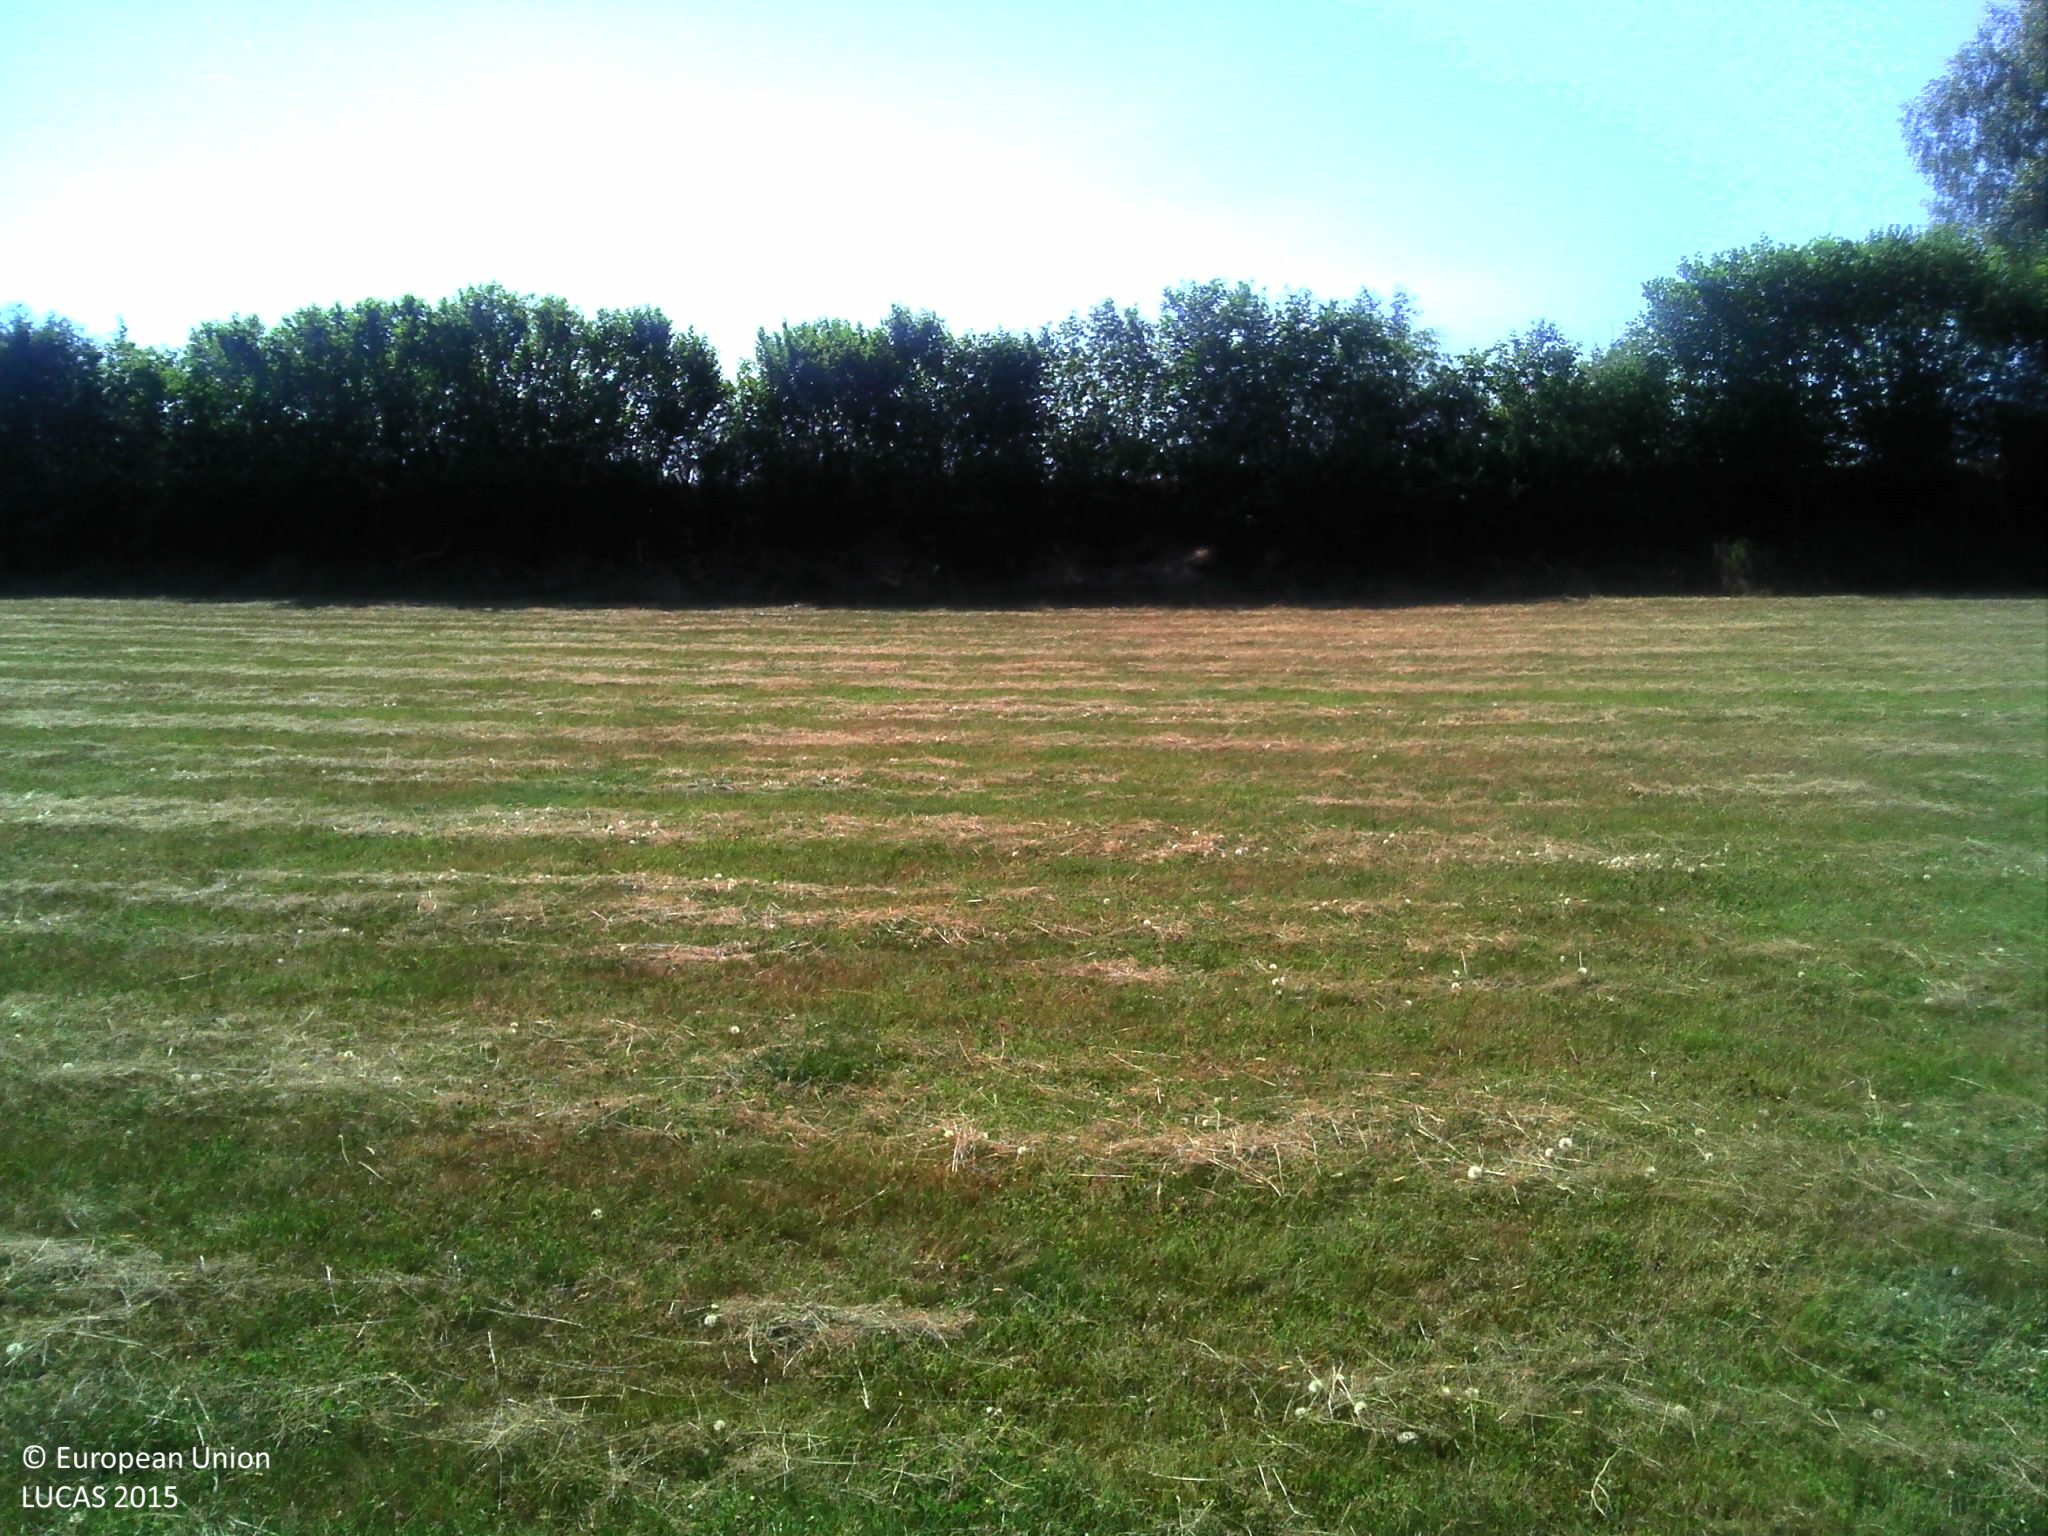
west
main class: Grassland
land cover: Grassland without tree/shrub cover
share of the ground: > 75 %
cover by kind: herbaceous plants 100 %
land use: Agriculture (excluding fallow land and kitchen gardens)
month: July
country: FR
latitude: 46.0271
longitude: 1.6858
